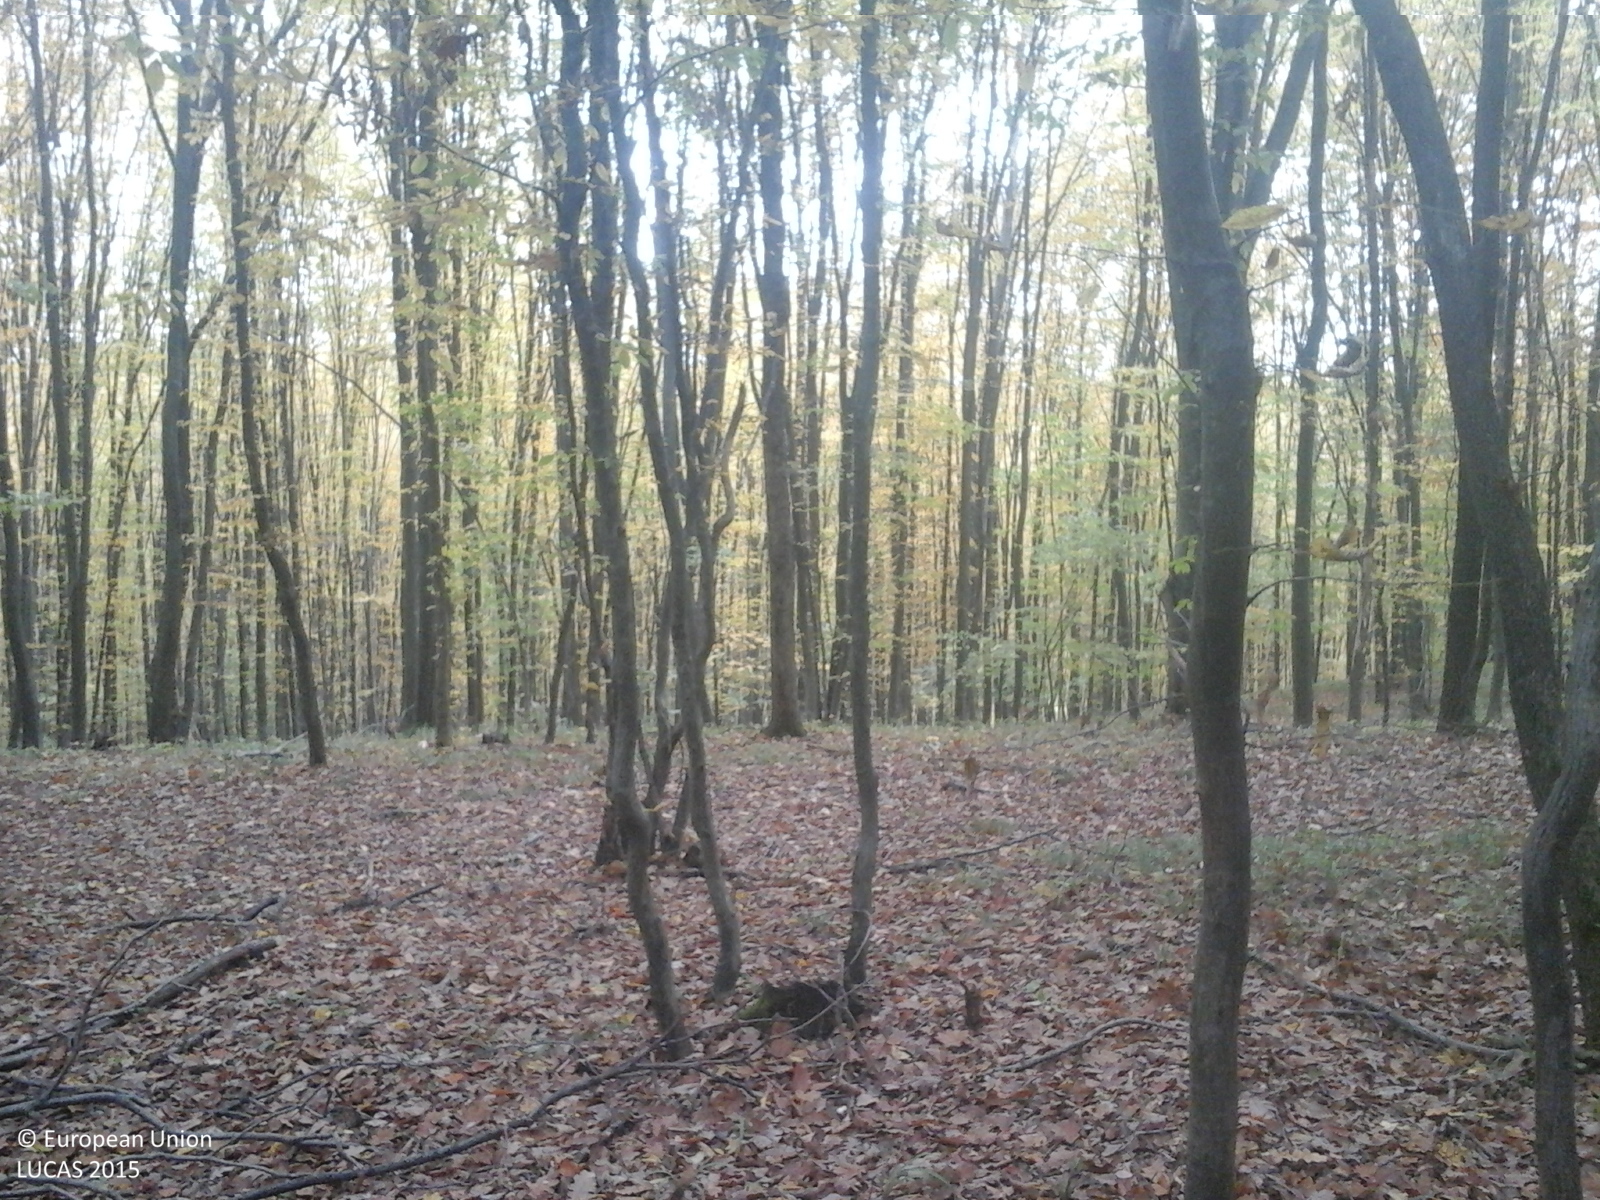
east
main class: Woodland
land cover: Broadleaved woodland
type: acidophilous oak and oak-birch forest
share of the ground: > 75 %
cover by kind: broadleaved forest trees 100 %
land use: Forestry
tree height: > 5 m
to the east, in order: Broadleaved woodland; Grassland without tree/shrub cover
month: October
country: RO
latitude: 44.9916
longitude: 25.5077
